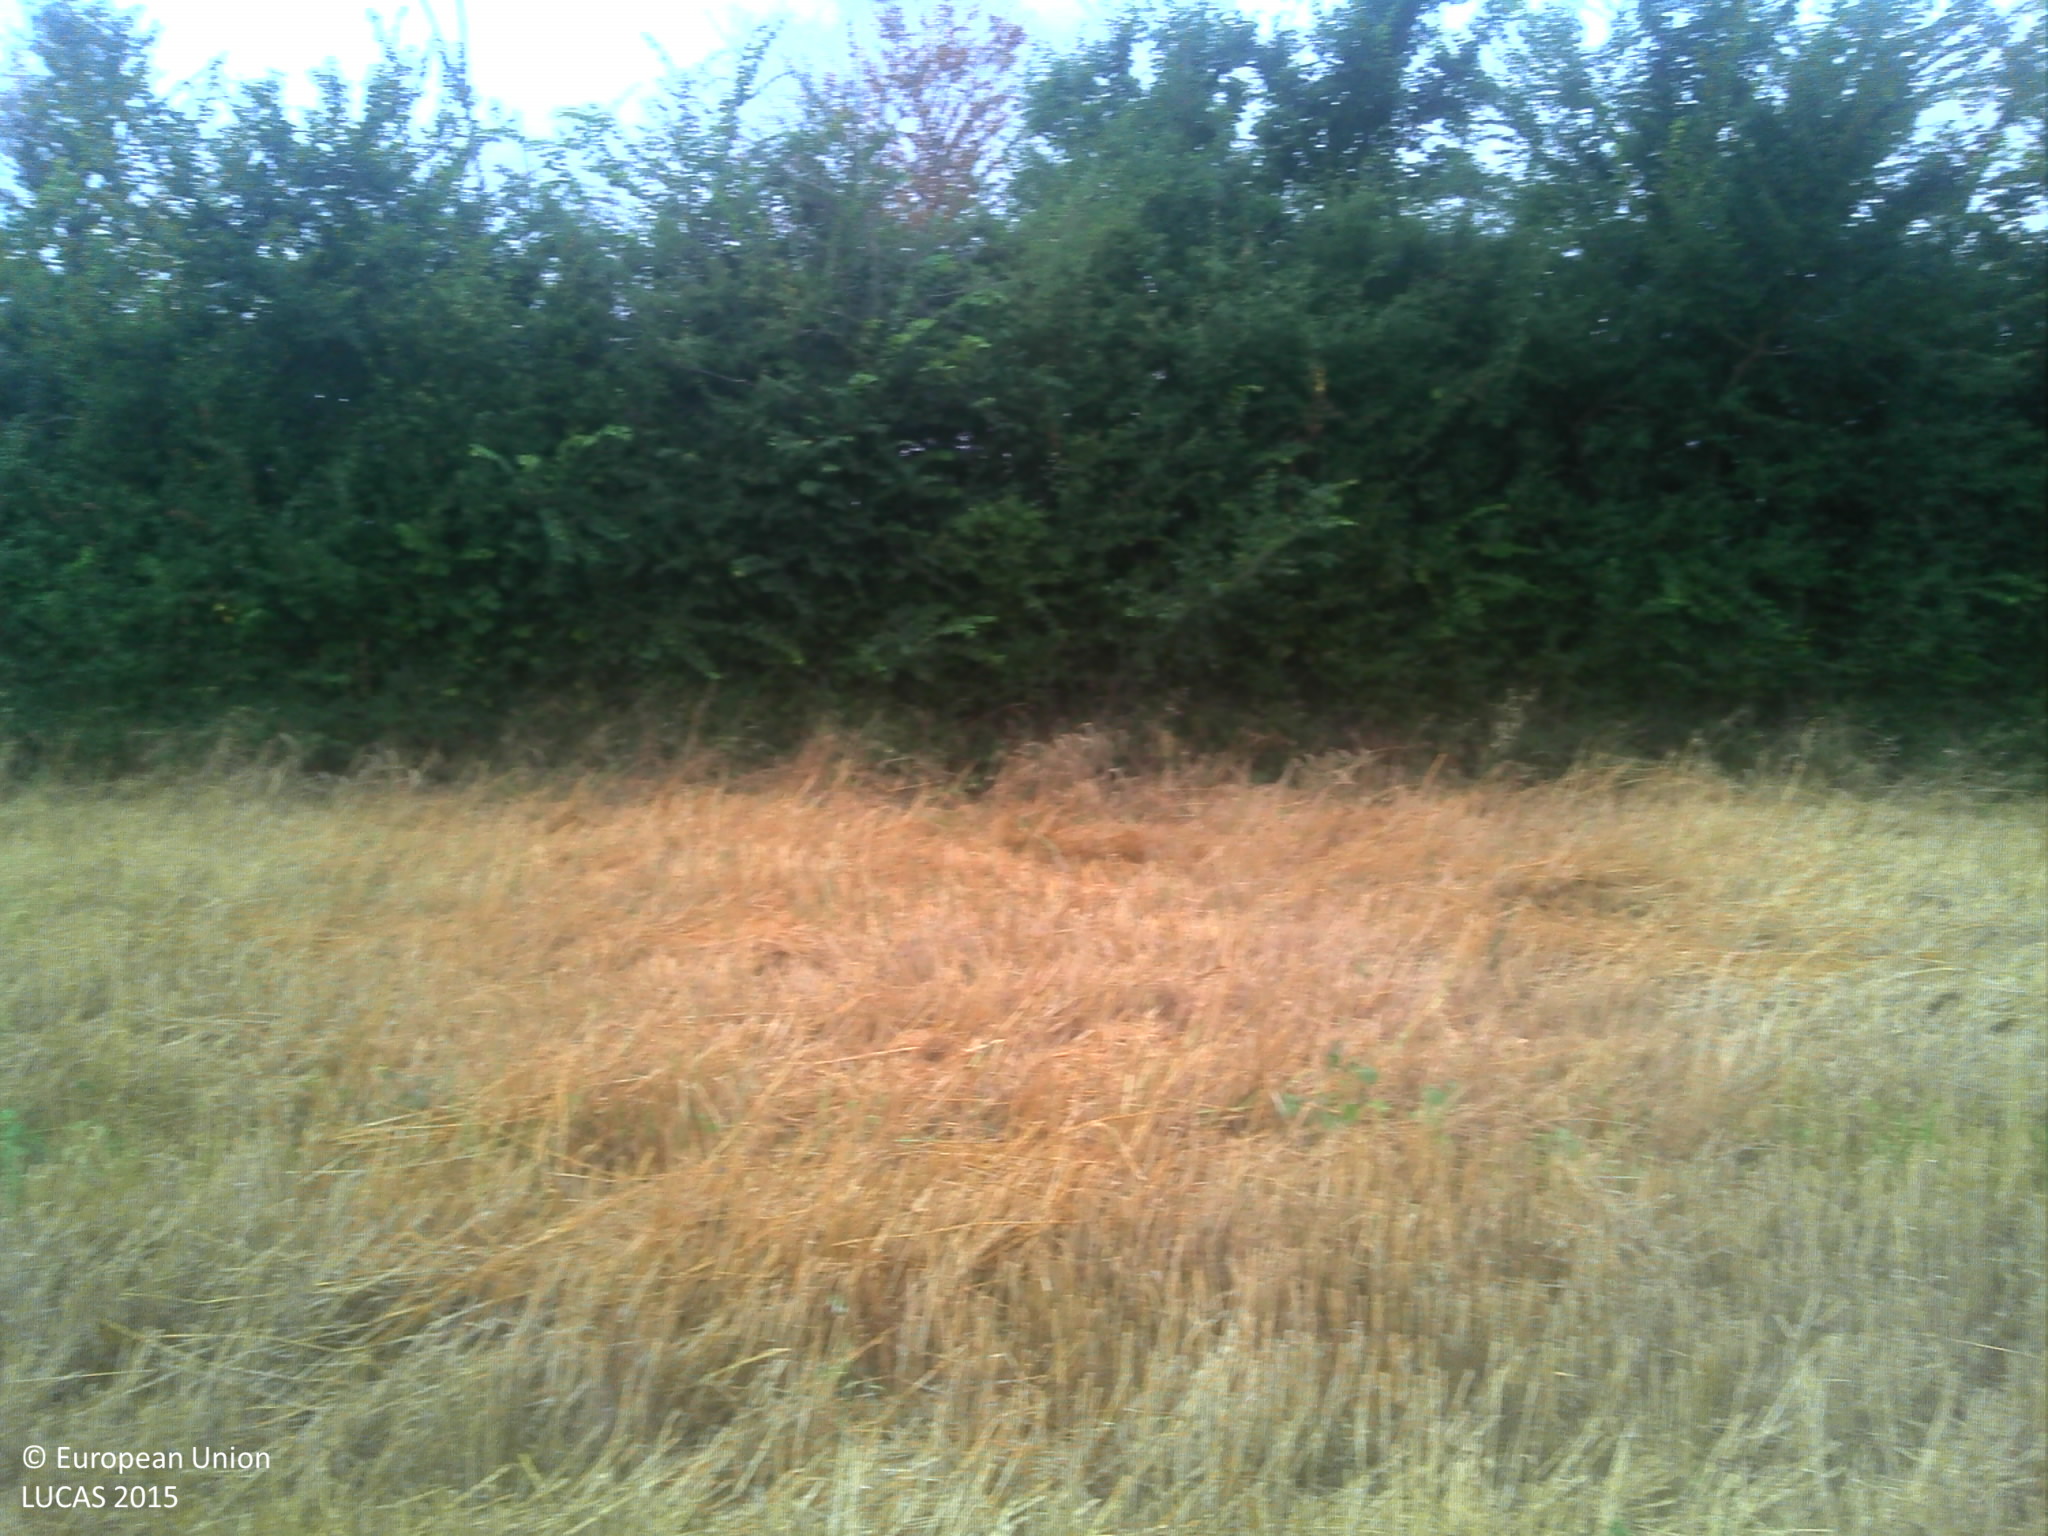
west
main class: Cropland
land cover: Common wheat
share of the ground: > 75 %
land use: Agriculture (excluding fallow land and kitchen gardens)
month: July
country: FR
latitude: 43.3448
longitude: 1.4553
